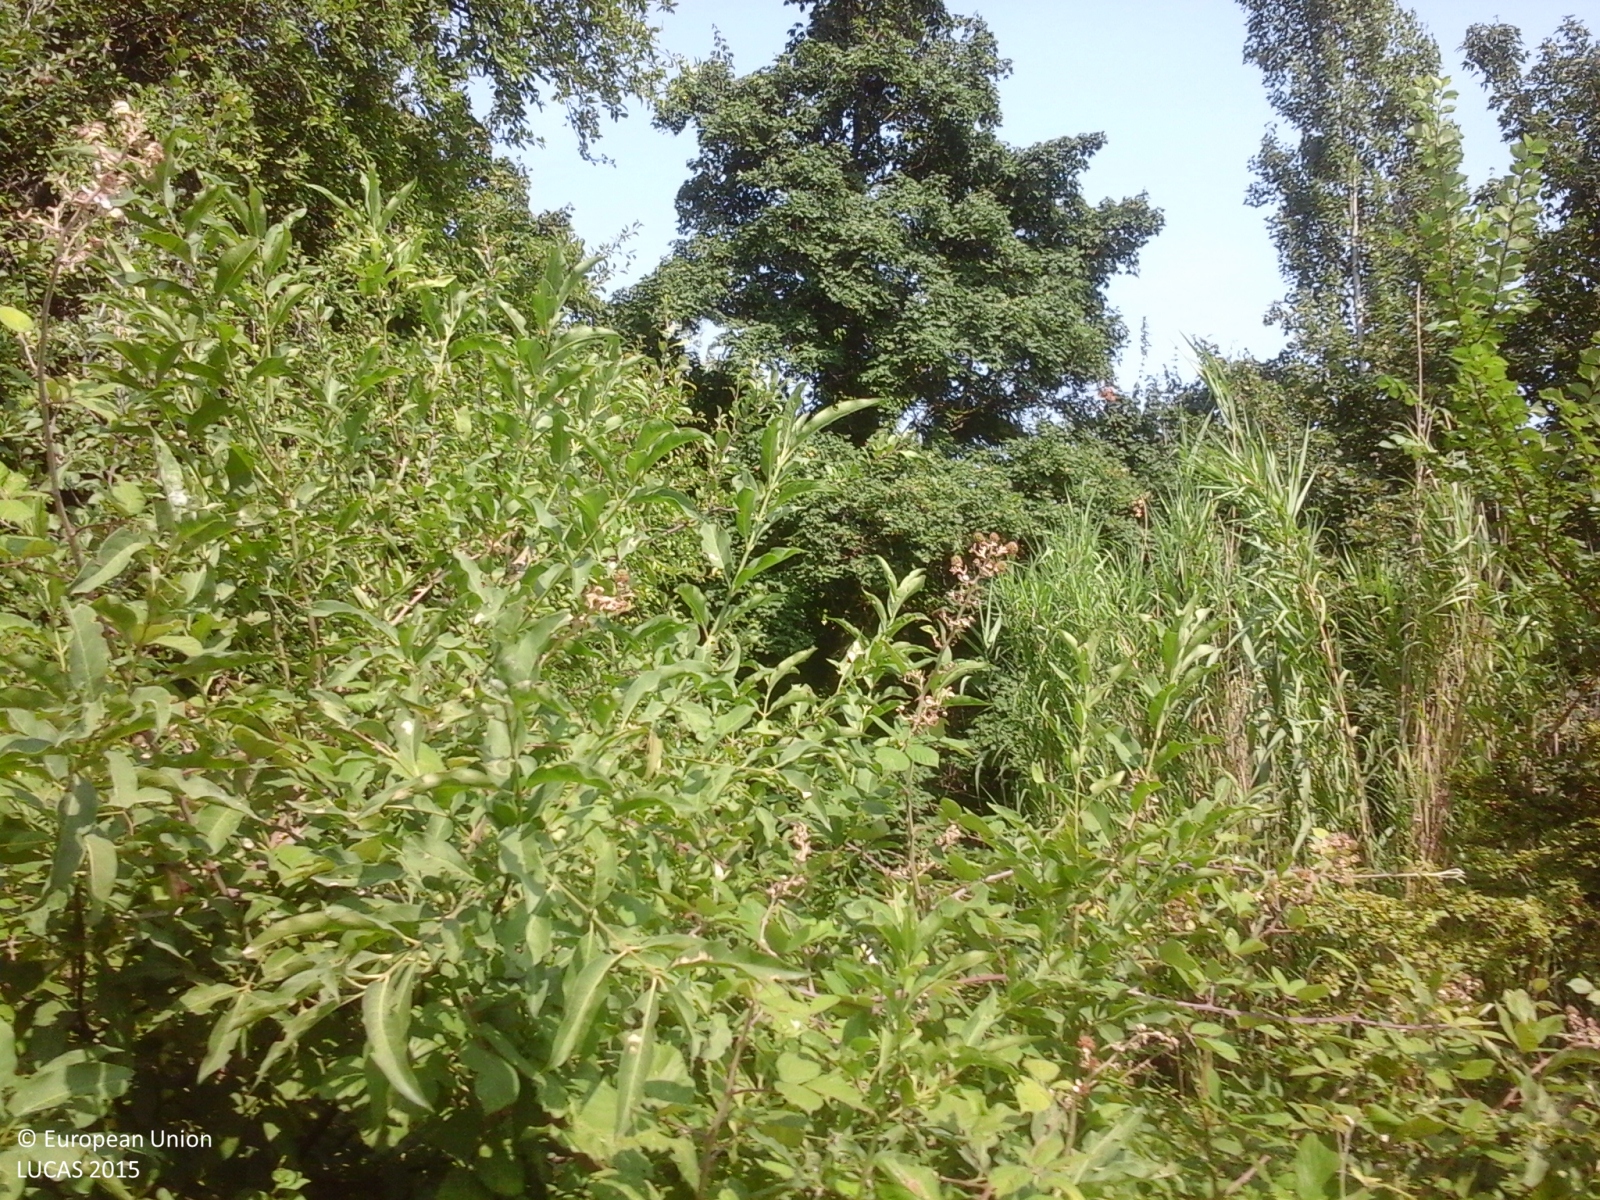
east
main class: Shrubland
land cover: Shrubland without tree cover
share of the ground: > 75 %
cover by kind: shrubs 95 %, herbaceous plants 5 %
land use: Semi-natural and natural areas not in use
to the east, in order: Shrubland without tree cover; Broadleaved woodland; Electric lines; Broadleaved woodland; Grassland with sparse tree/shrub cover; Broadleaved woodland; Grassland without tree/shrub cover; Broadleaved woodland; Grassland without tree/shrub cover; Electric lines; Paved roads, cycling and walking lanes; Fences; Grassland without tree/shrub cover; Broadleaved woodland
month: July
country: IT
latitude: 43.0515
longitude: 13.3179
